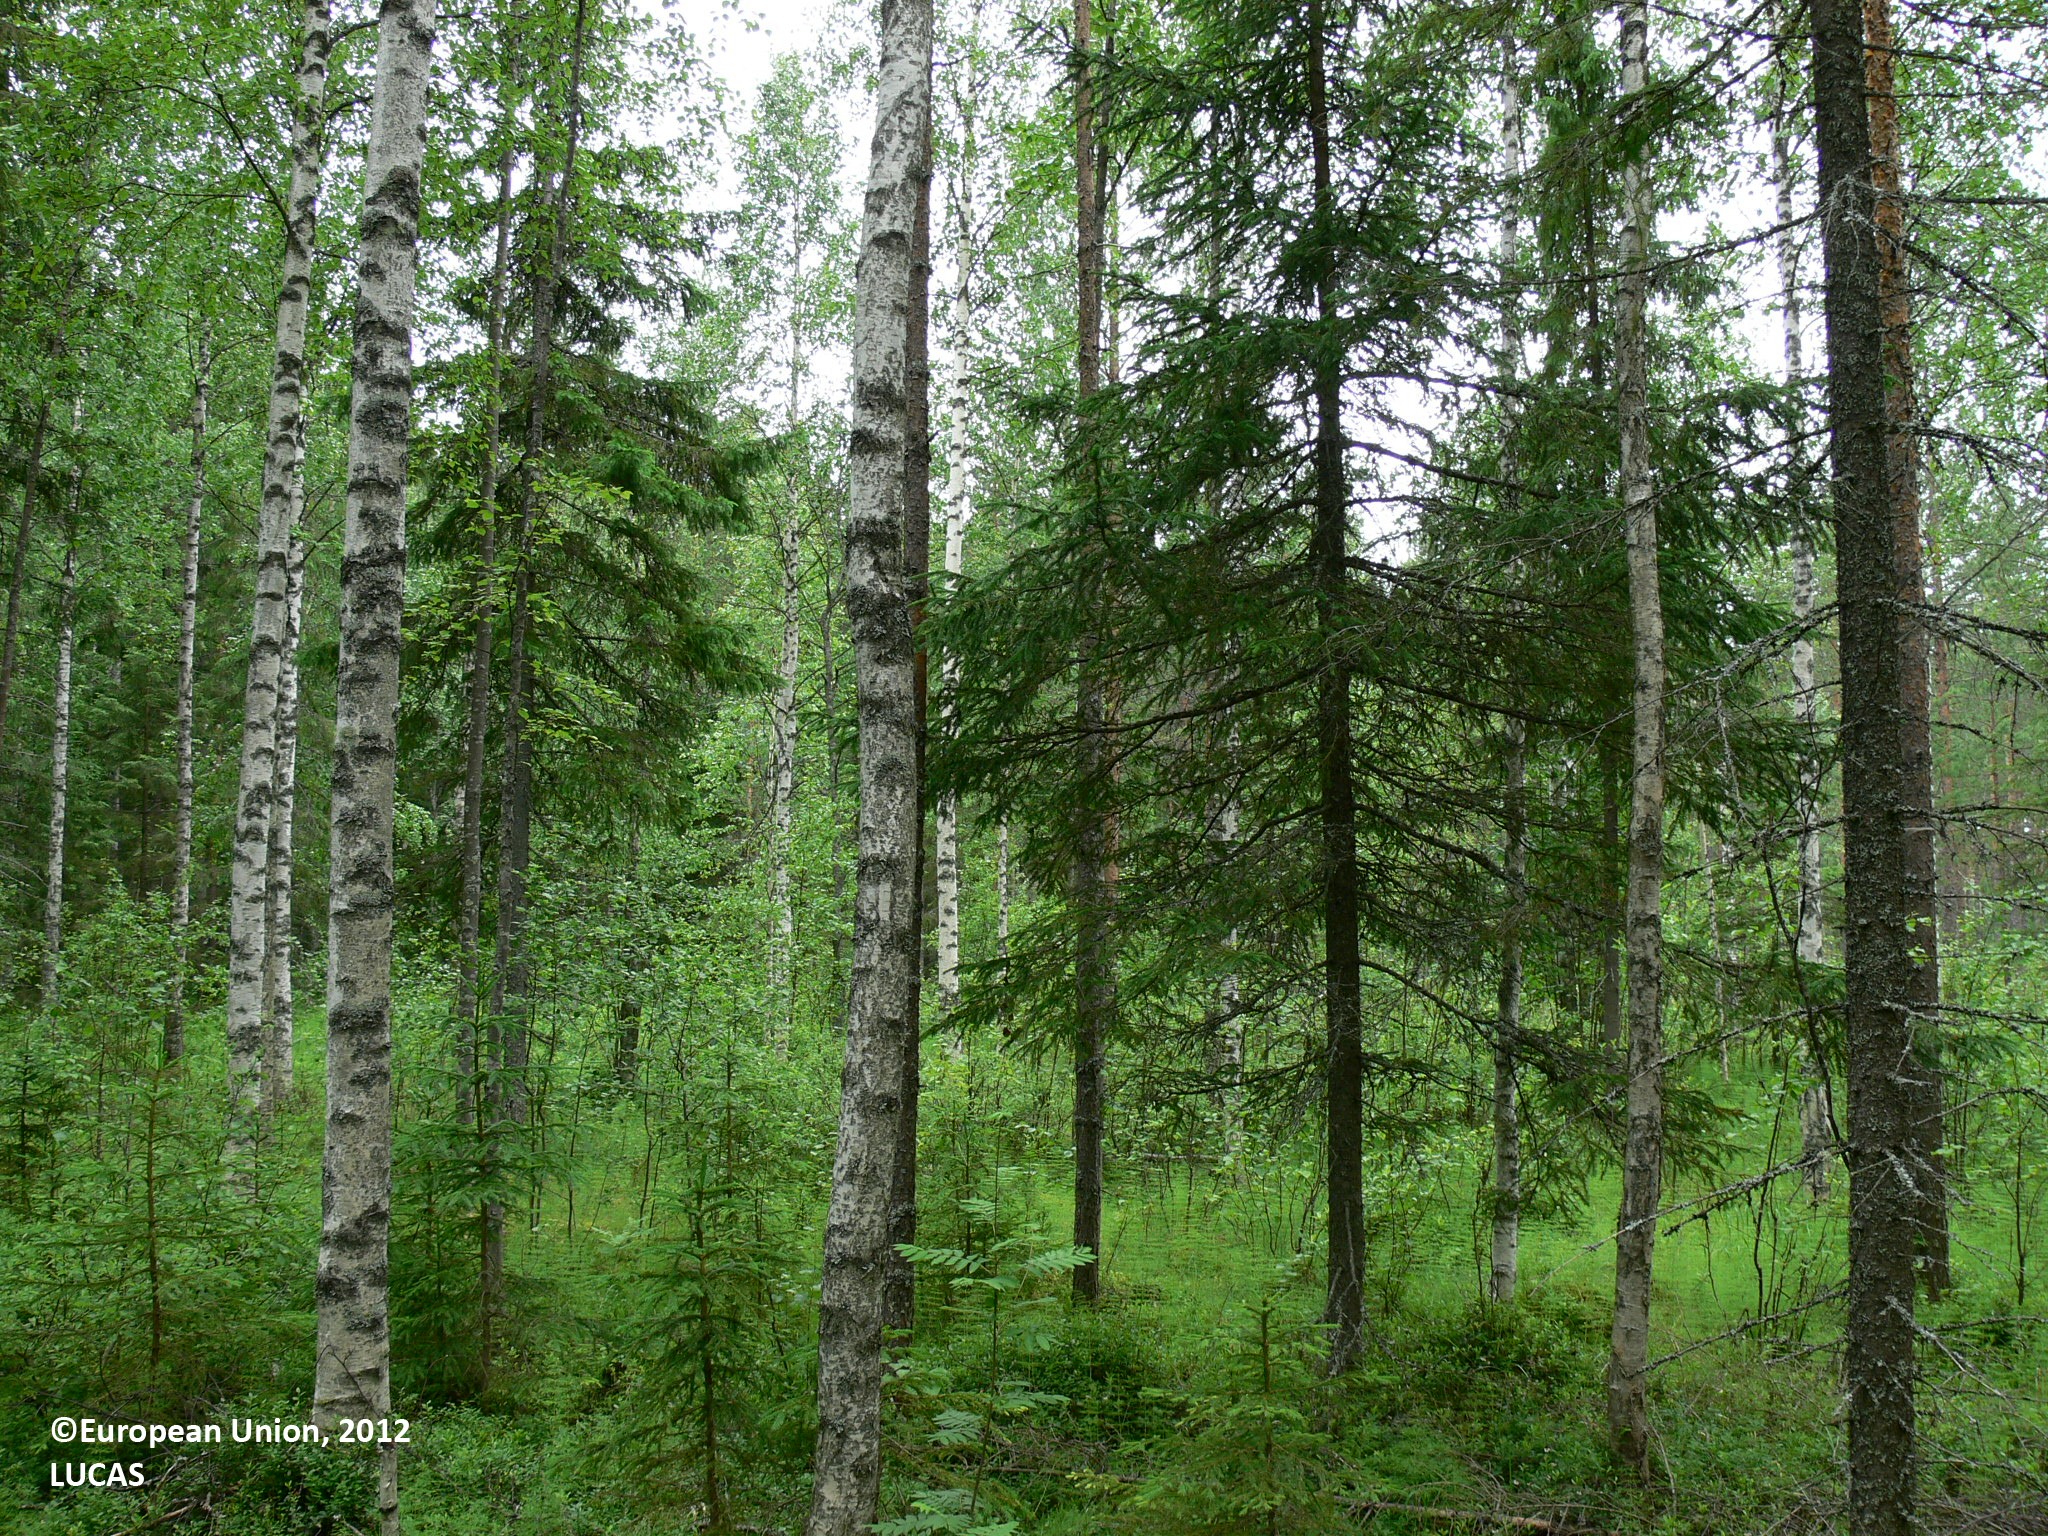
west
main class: Woodland
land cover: Other mixed woodland
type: boreal forest
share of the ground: > 75 %
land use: Forestry
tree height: > 5 m
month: June
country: FI
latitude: 62.8462
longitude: 29.3800
